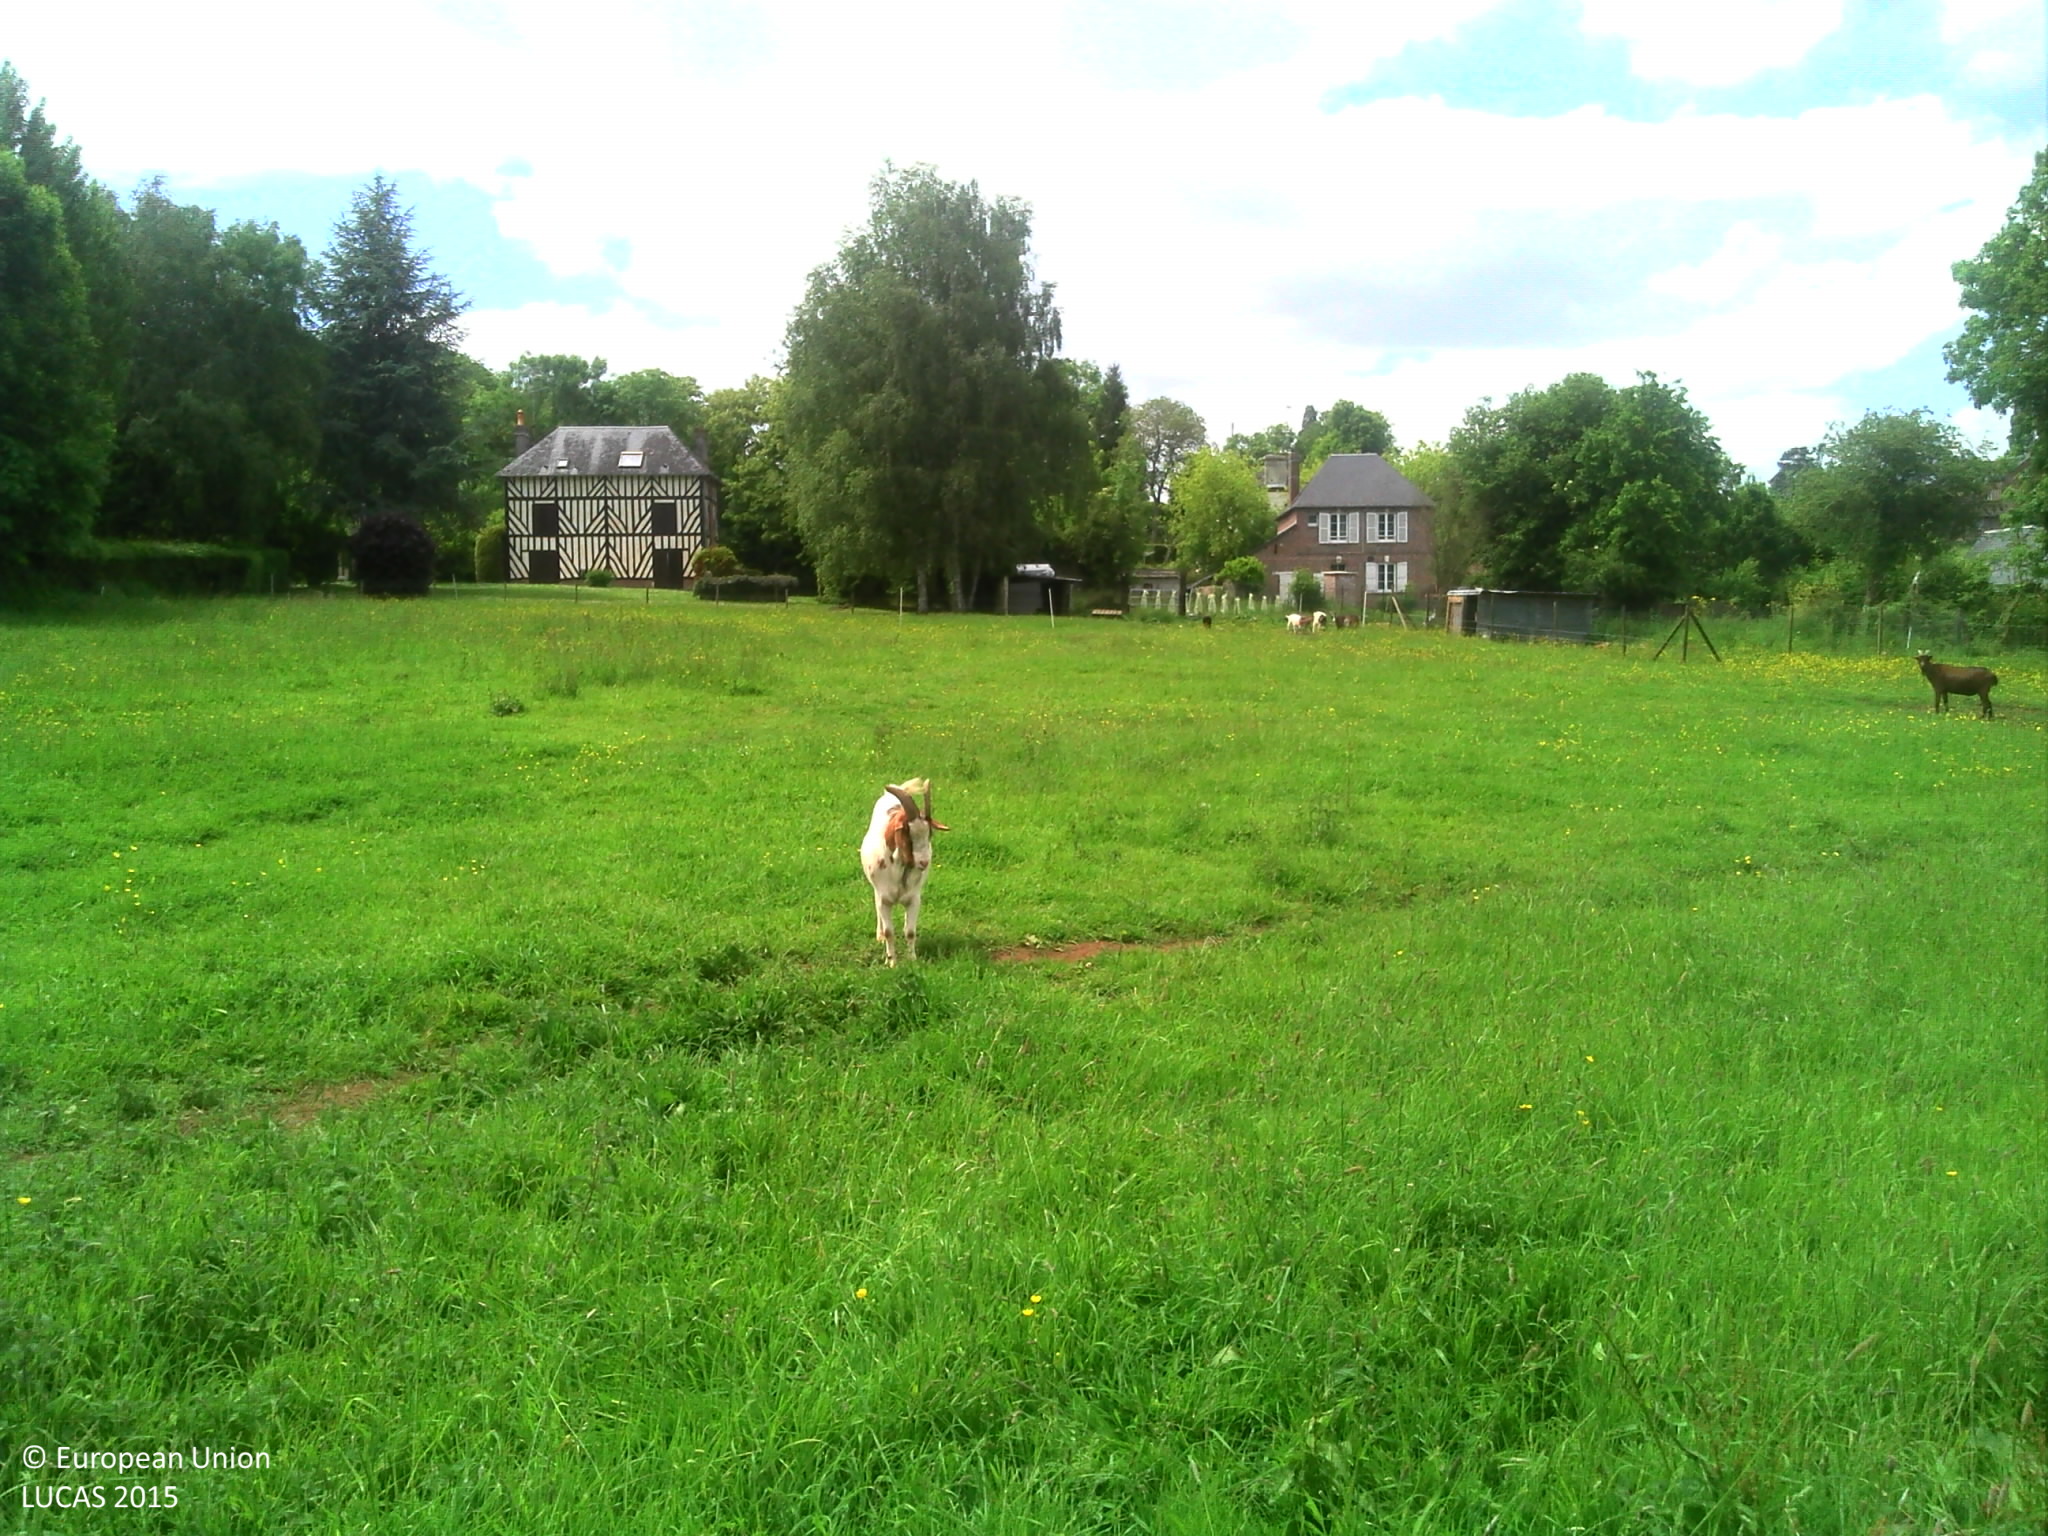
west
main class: Grassland
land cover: Grassland without tree/shrub cover
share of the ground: > 75 %
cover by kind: herbaceous plants 95 %
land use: Agriculture (excluding fallow land and kitchen gardens)
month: June
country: FR
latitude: 48.9191
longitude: 0.1039
